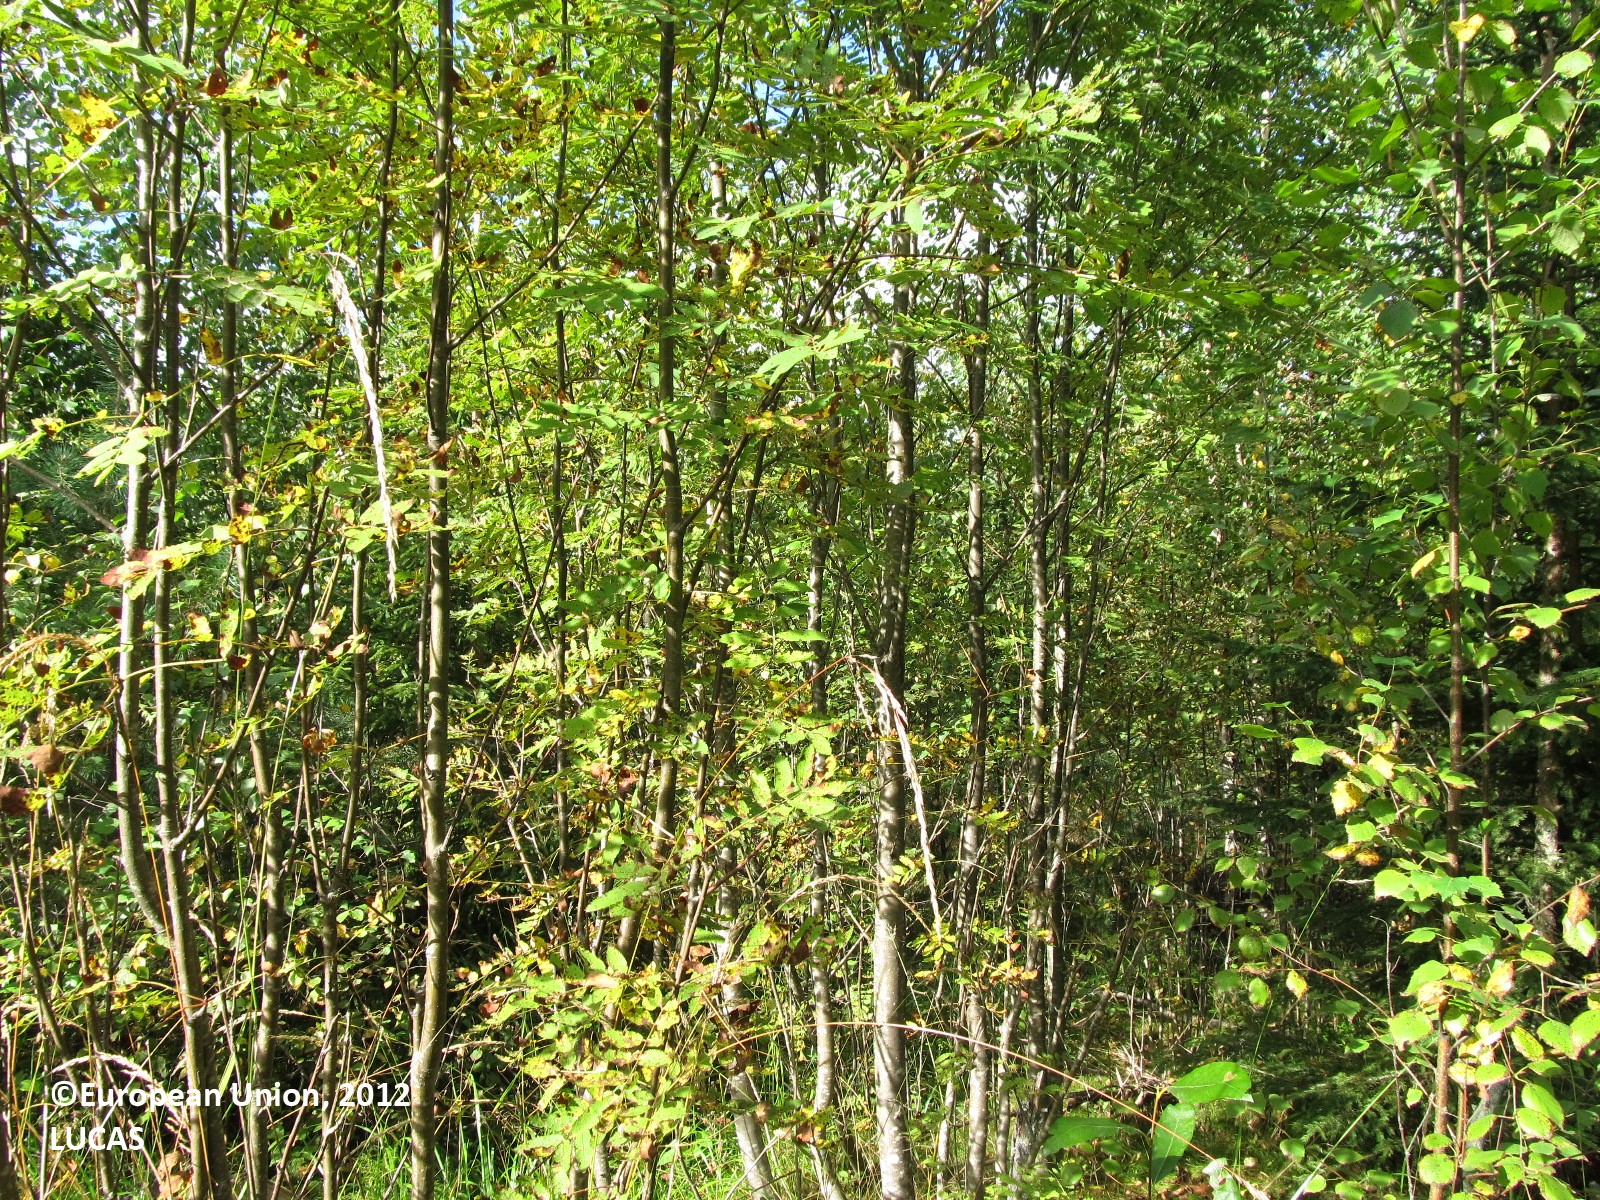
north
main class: Woodland
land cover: Broadleaved woodland
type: boreal forest
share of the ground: 50 - 75 %
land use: Forestry
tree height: < 5 m
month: August
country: FI
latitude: 62.0150
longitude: 27.5384
